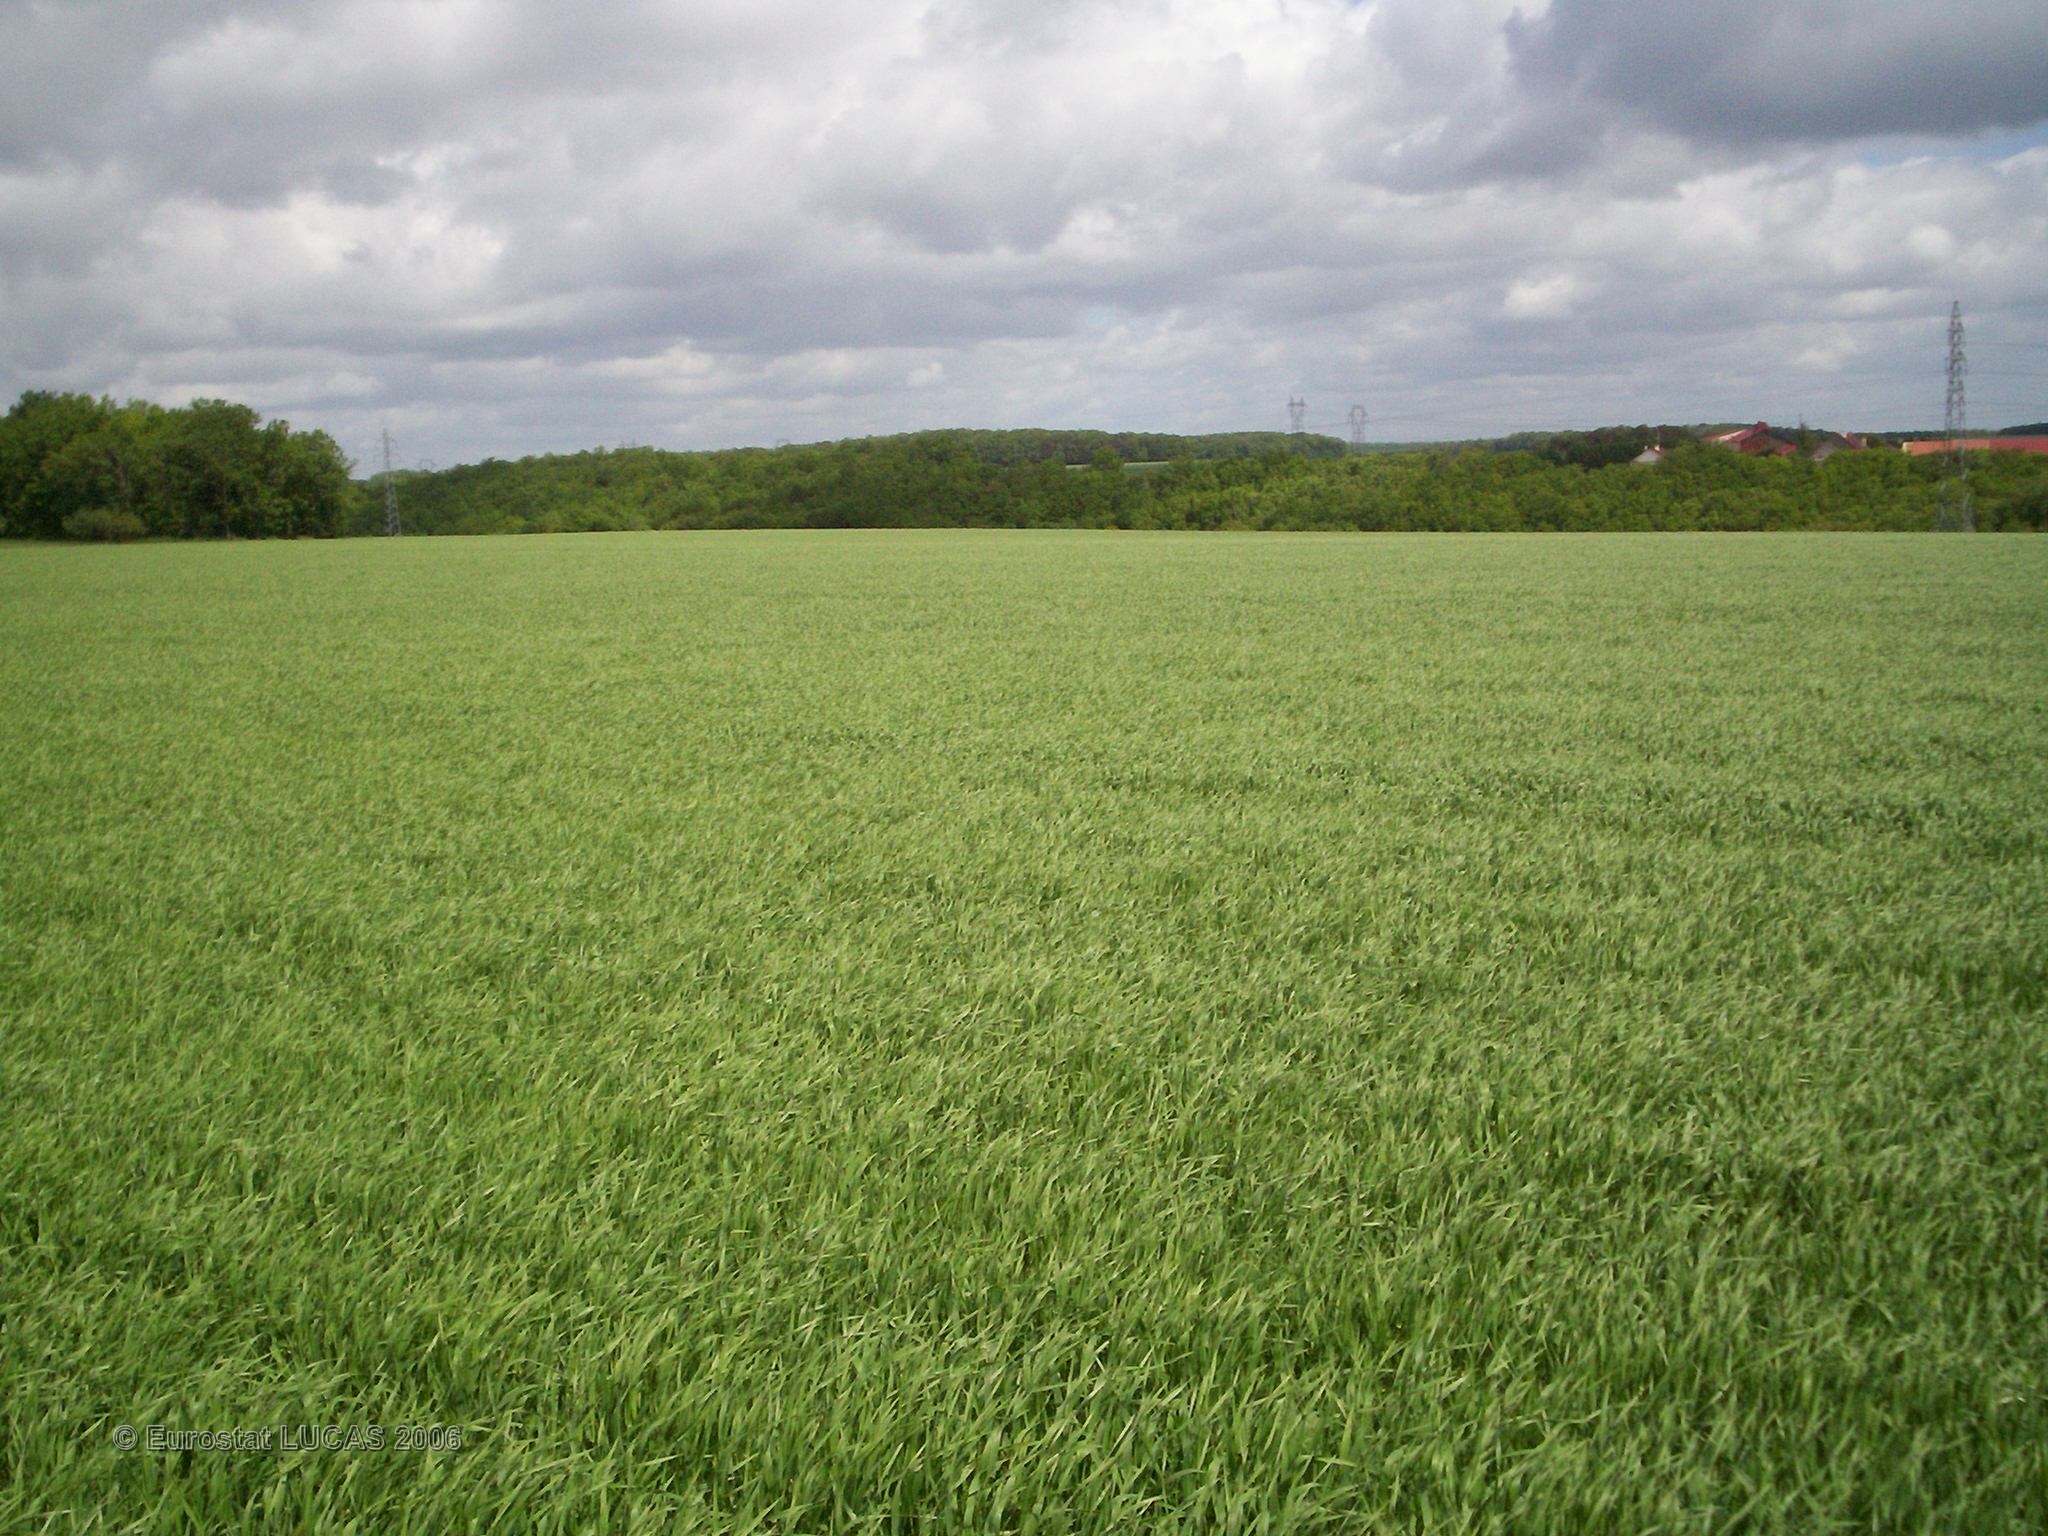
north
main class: Cropland
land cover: Barley
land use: Agriculture (excluding fallow land and kitchen gardens)
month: May
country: FR
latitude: 47.7703
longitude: 3.9791
